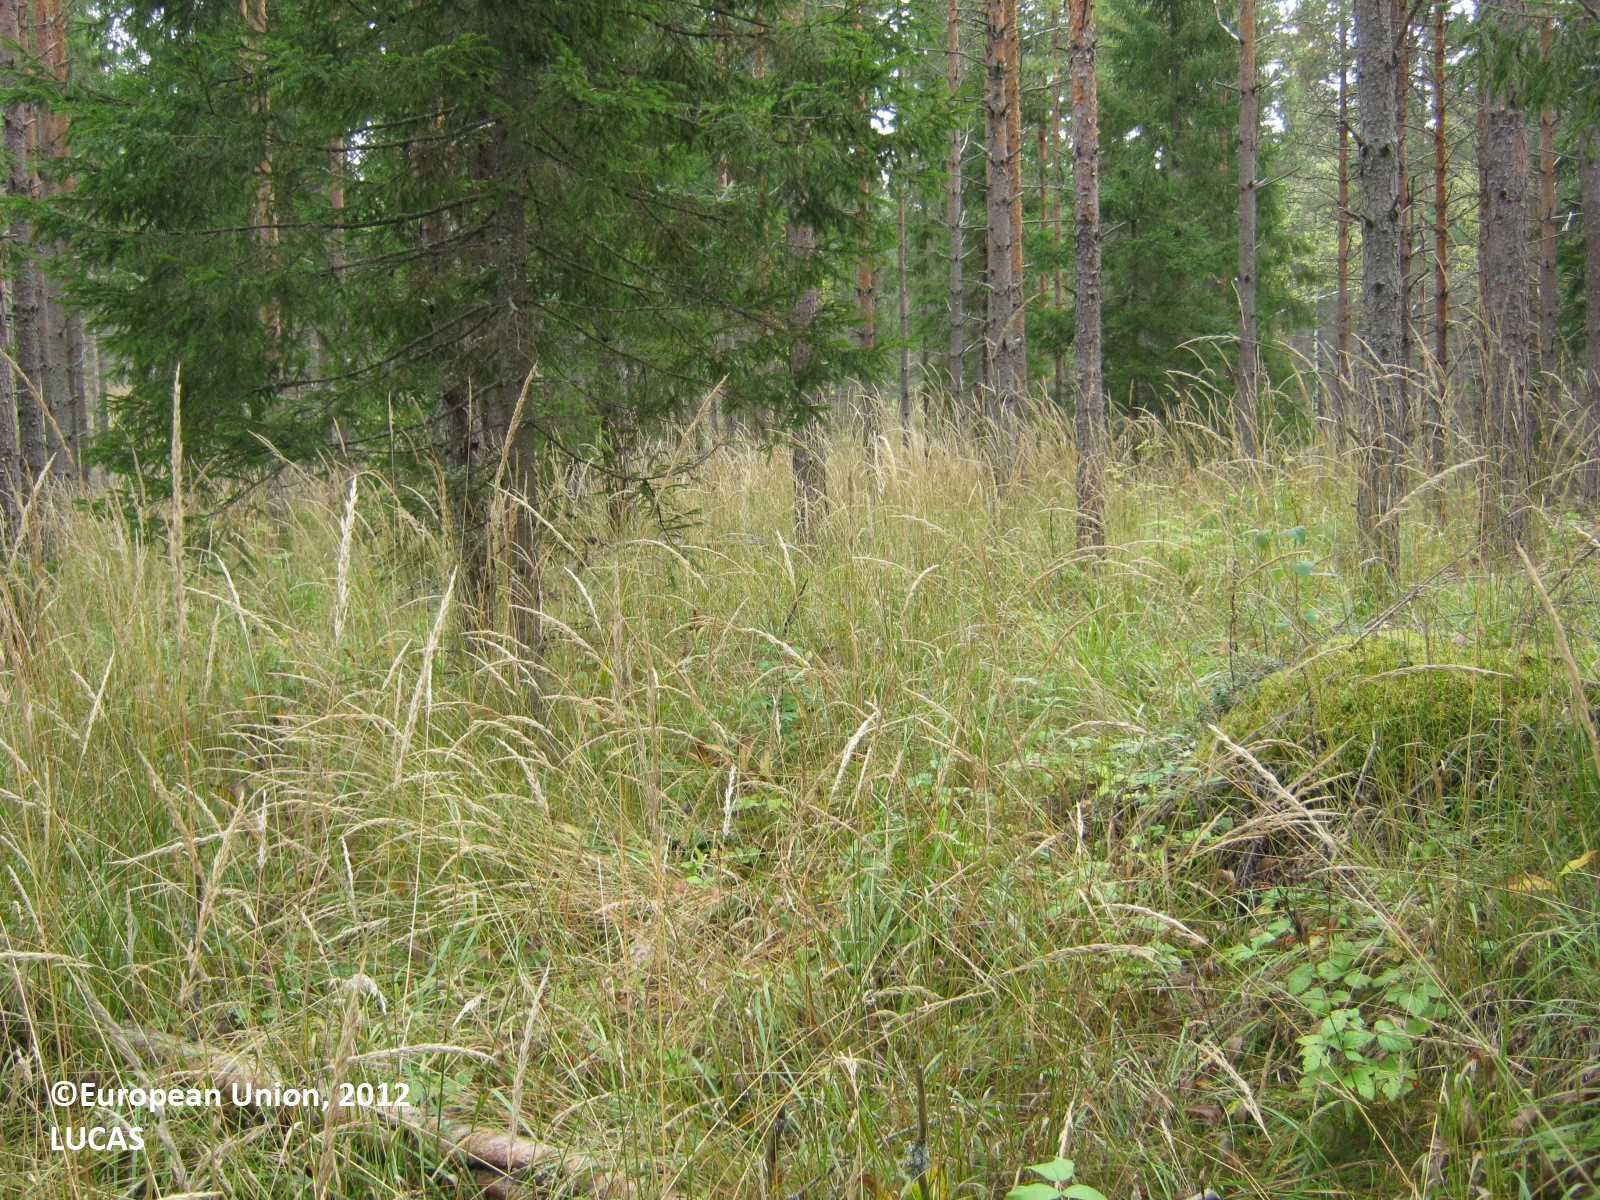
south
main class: Woodland
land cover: Pine dominated coniferous woodland
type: boreal forest
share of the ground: > 75 %
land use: Forestry
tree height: > 5 m
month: September
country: FI
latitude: 60.7371
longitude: 27.6677
